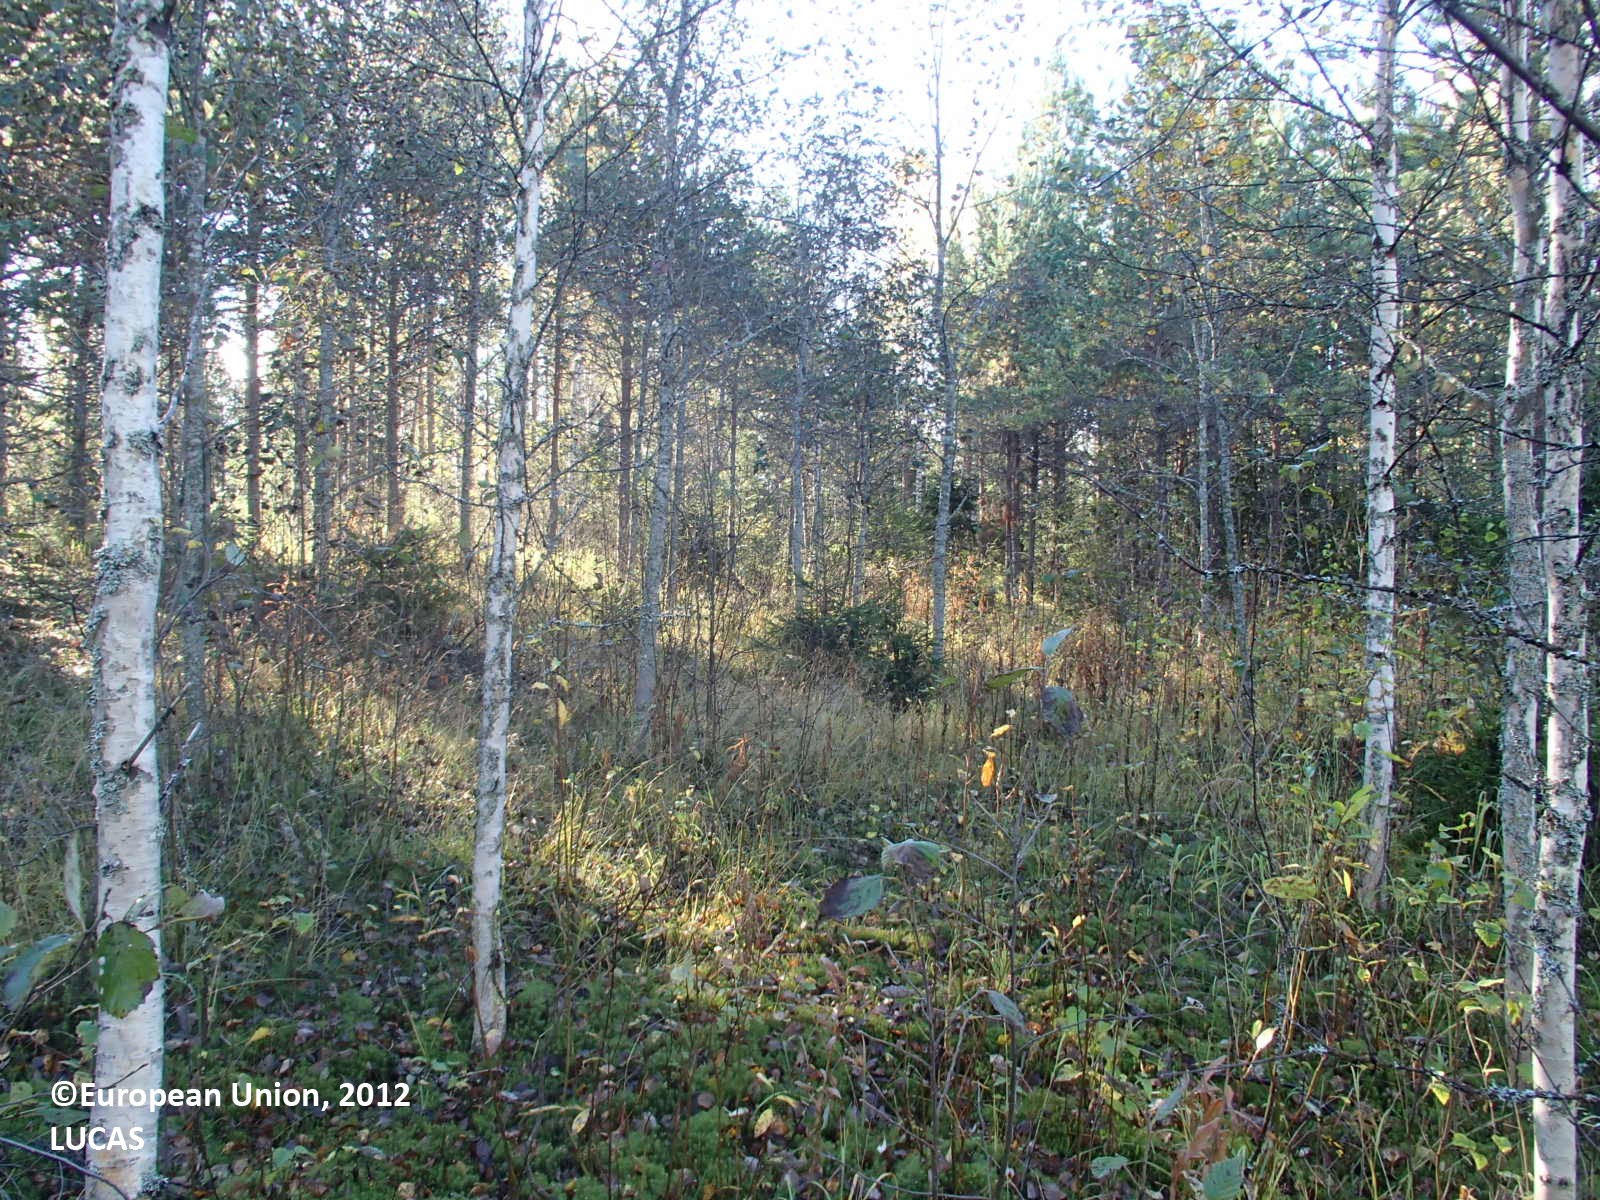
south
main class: Woodland
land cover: Pine dominated mixed woodland
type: boreal forest
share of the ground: 25 - 50 %
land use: Forestry
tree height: > 5 m
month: September
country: FI
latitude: 63.4246
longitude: 26.9083
